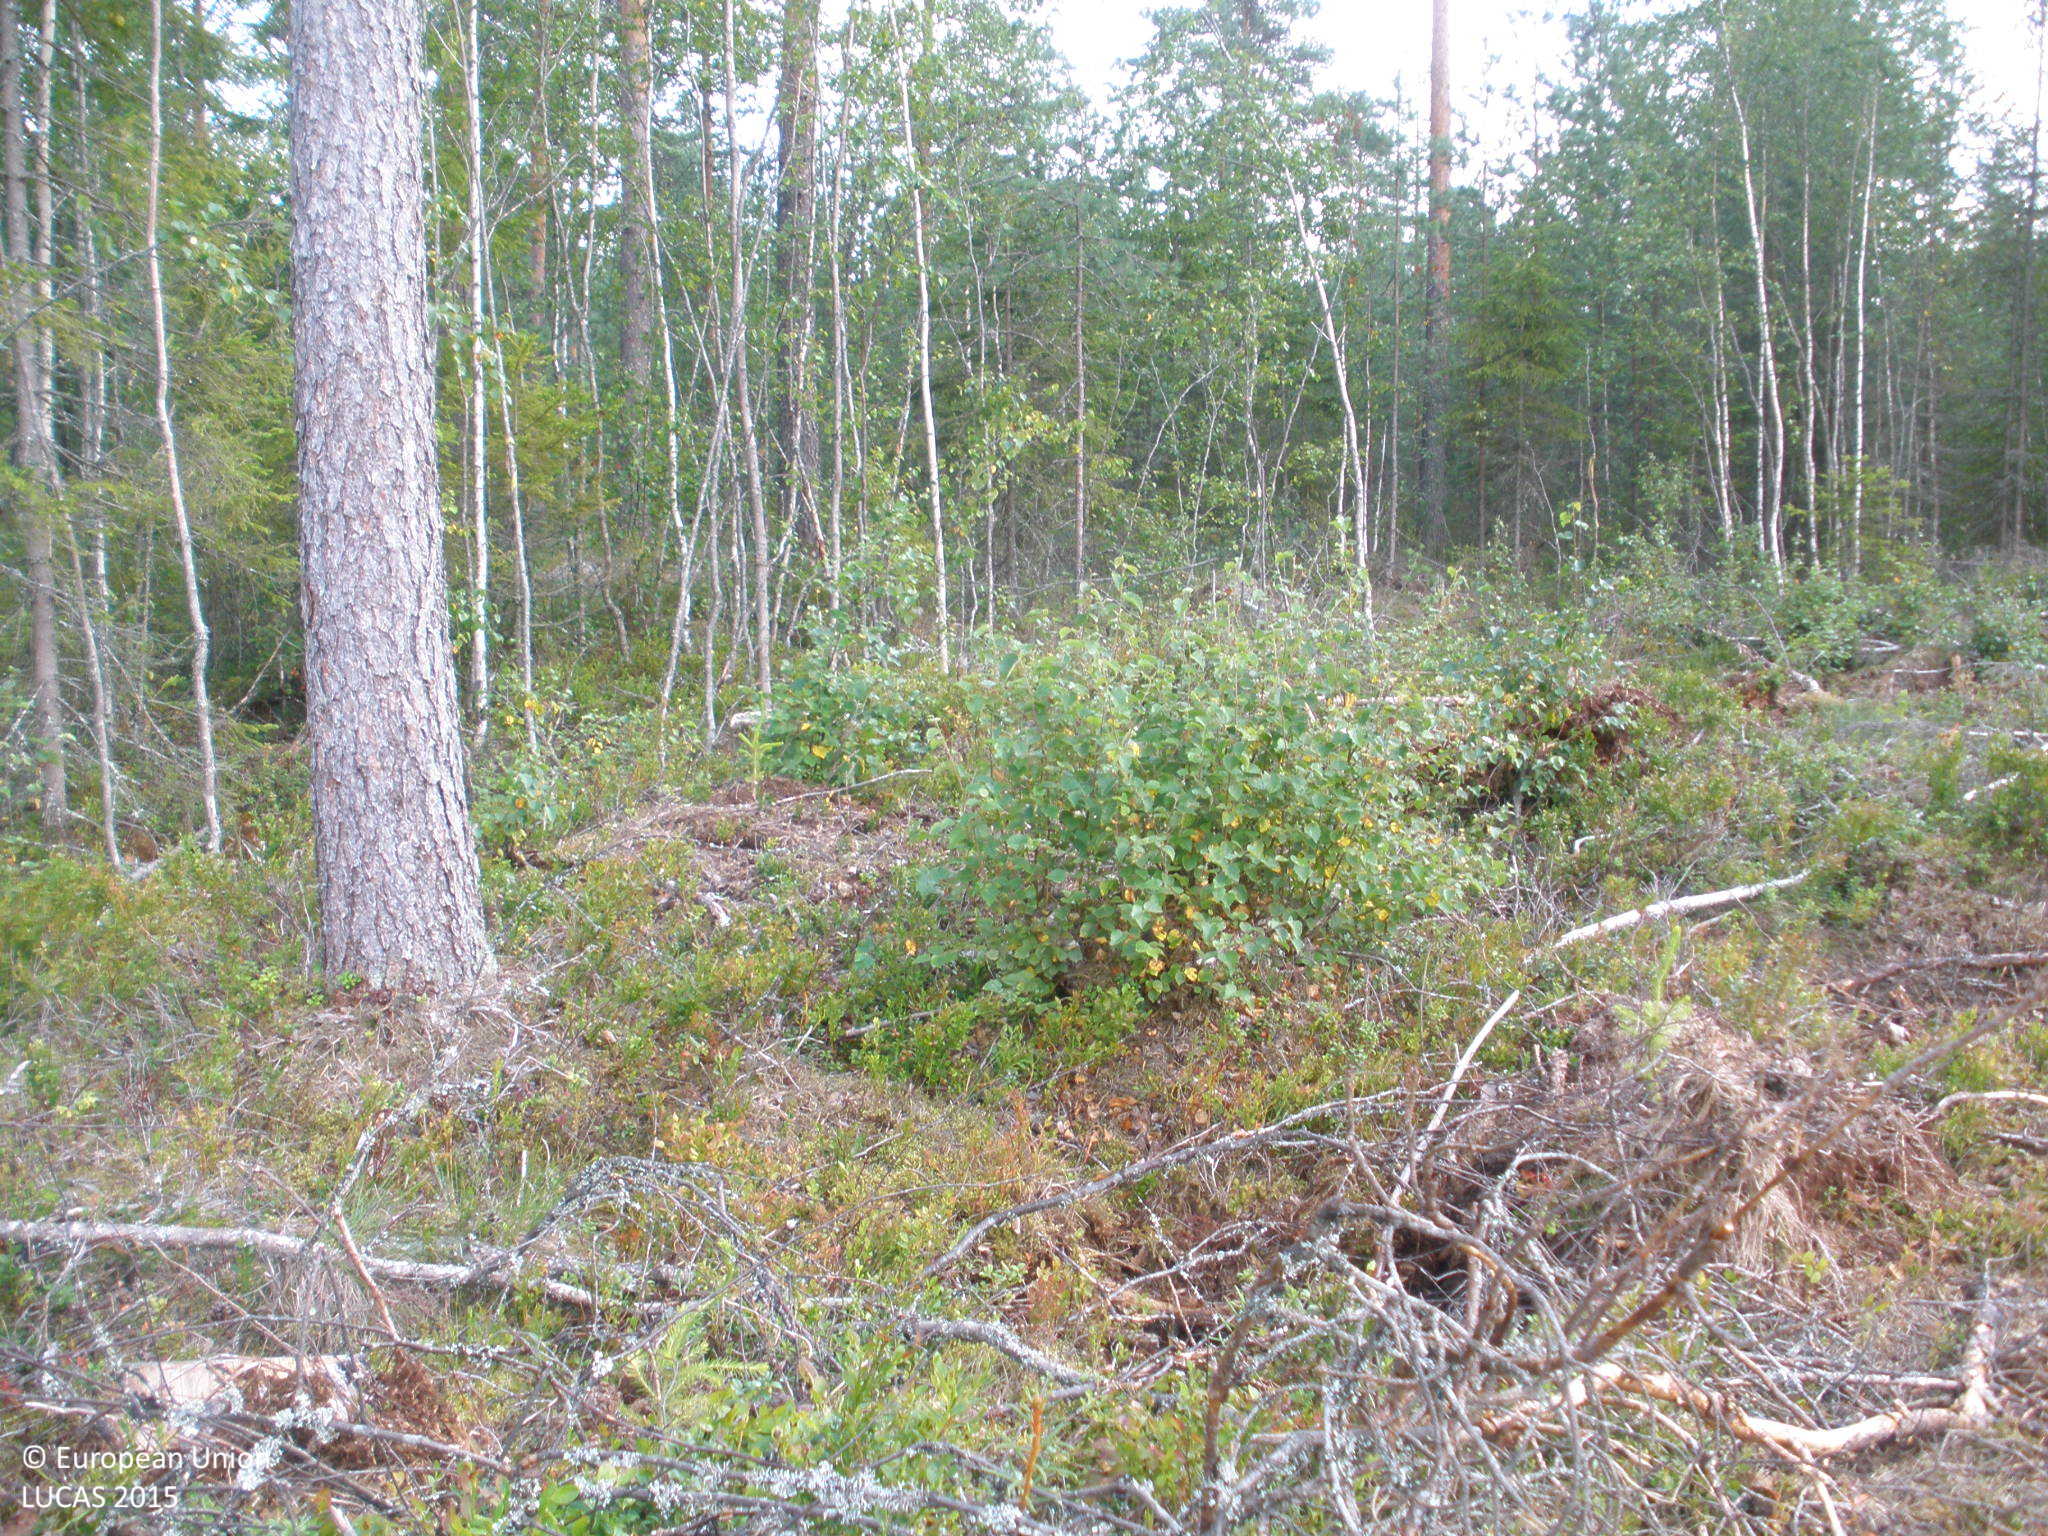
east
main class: Grassland
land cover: Grassland with sparse tree/shrub cover
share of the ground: 50 - 75 %
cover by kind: herbaceous plants 45 %, unconsolidated bare surface 25 %, consolidated bare surface 10 %, coniferous forest trees 5 %, shrubs 5 %
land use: Forestry
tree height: > 5 m
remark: Clear cut
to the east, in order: Grassland with sparse tree/shrub cover; Pine dominated mixed woodland; Ditches and canals; Spruce dominated mixed woodland; Pine dominated coniferous woodland; Pine dominated mixed woodland
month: August
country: FI
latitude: 60.6596
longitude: 24.2795
